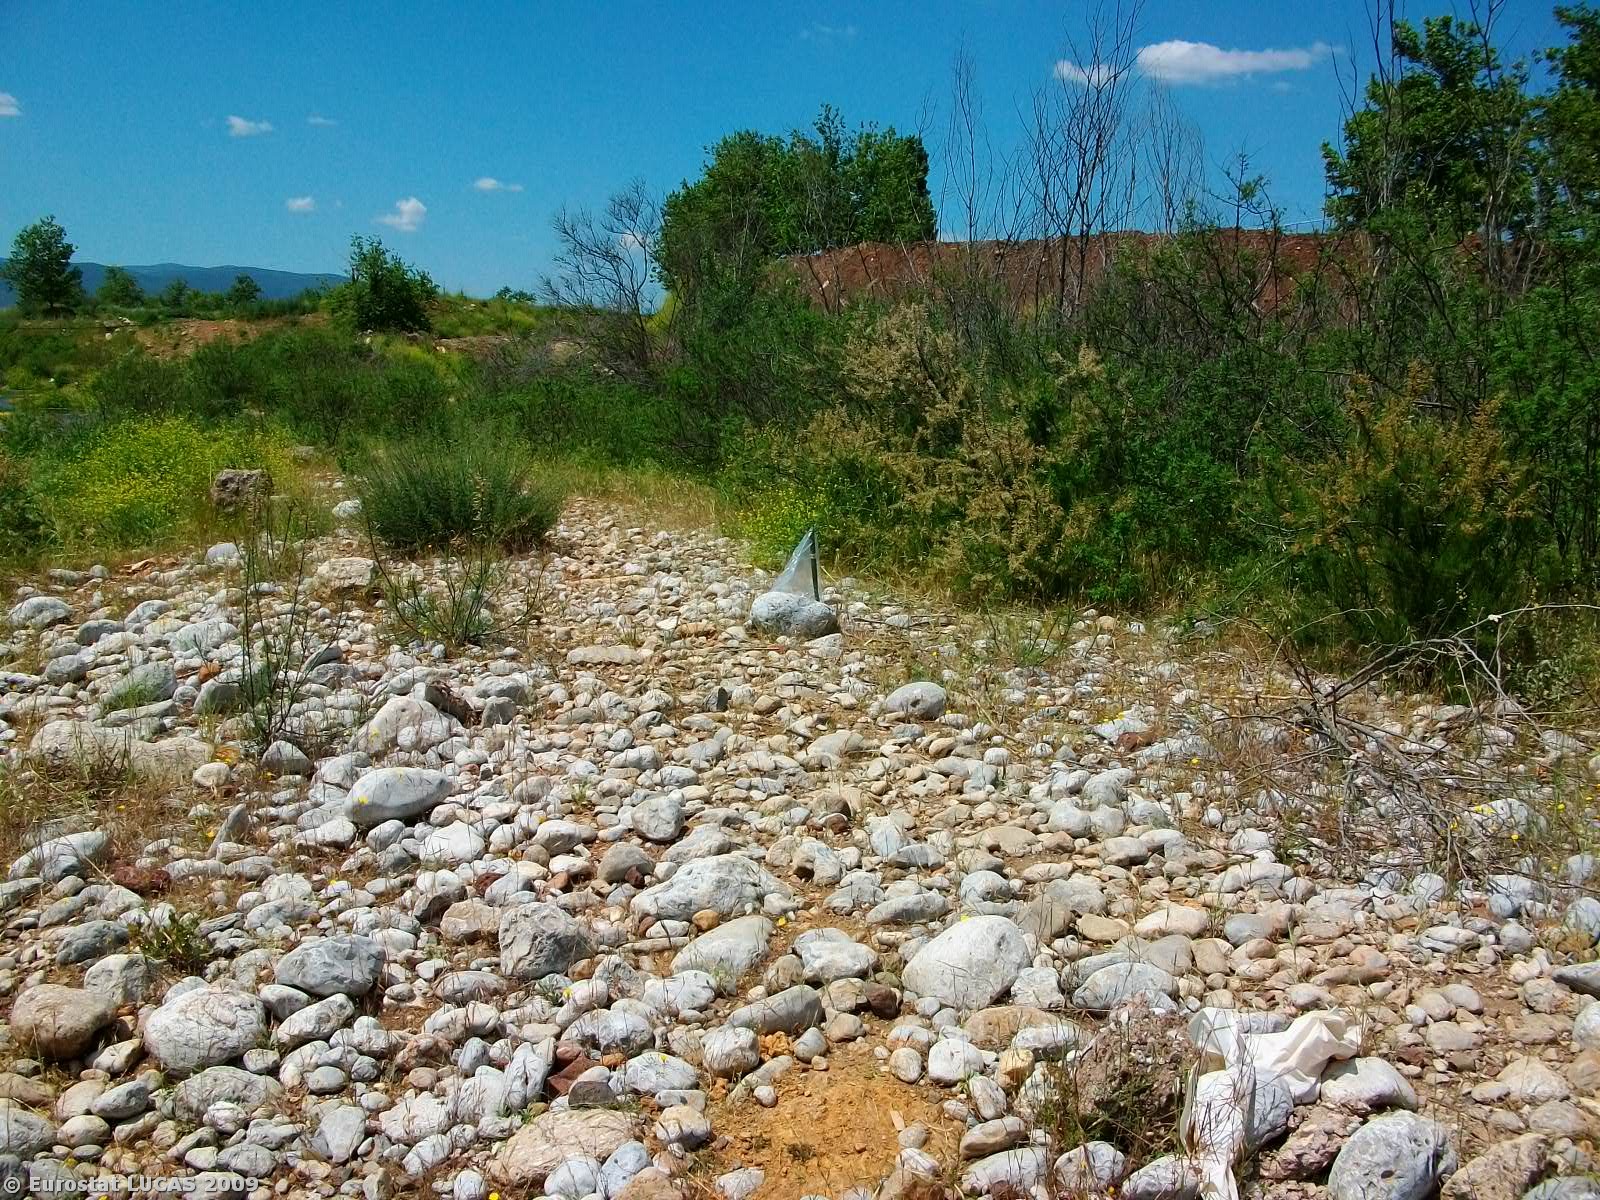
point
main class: Bare land
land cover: Bare land
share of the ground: > 75 %
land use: Unused
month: May
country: GR
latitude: 39.1750
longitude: 22.7546
